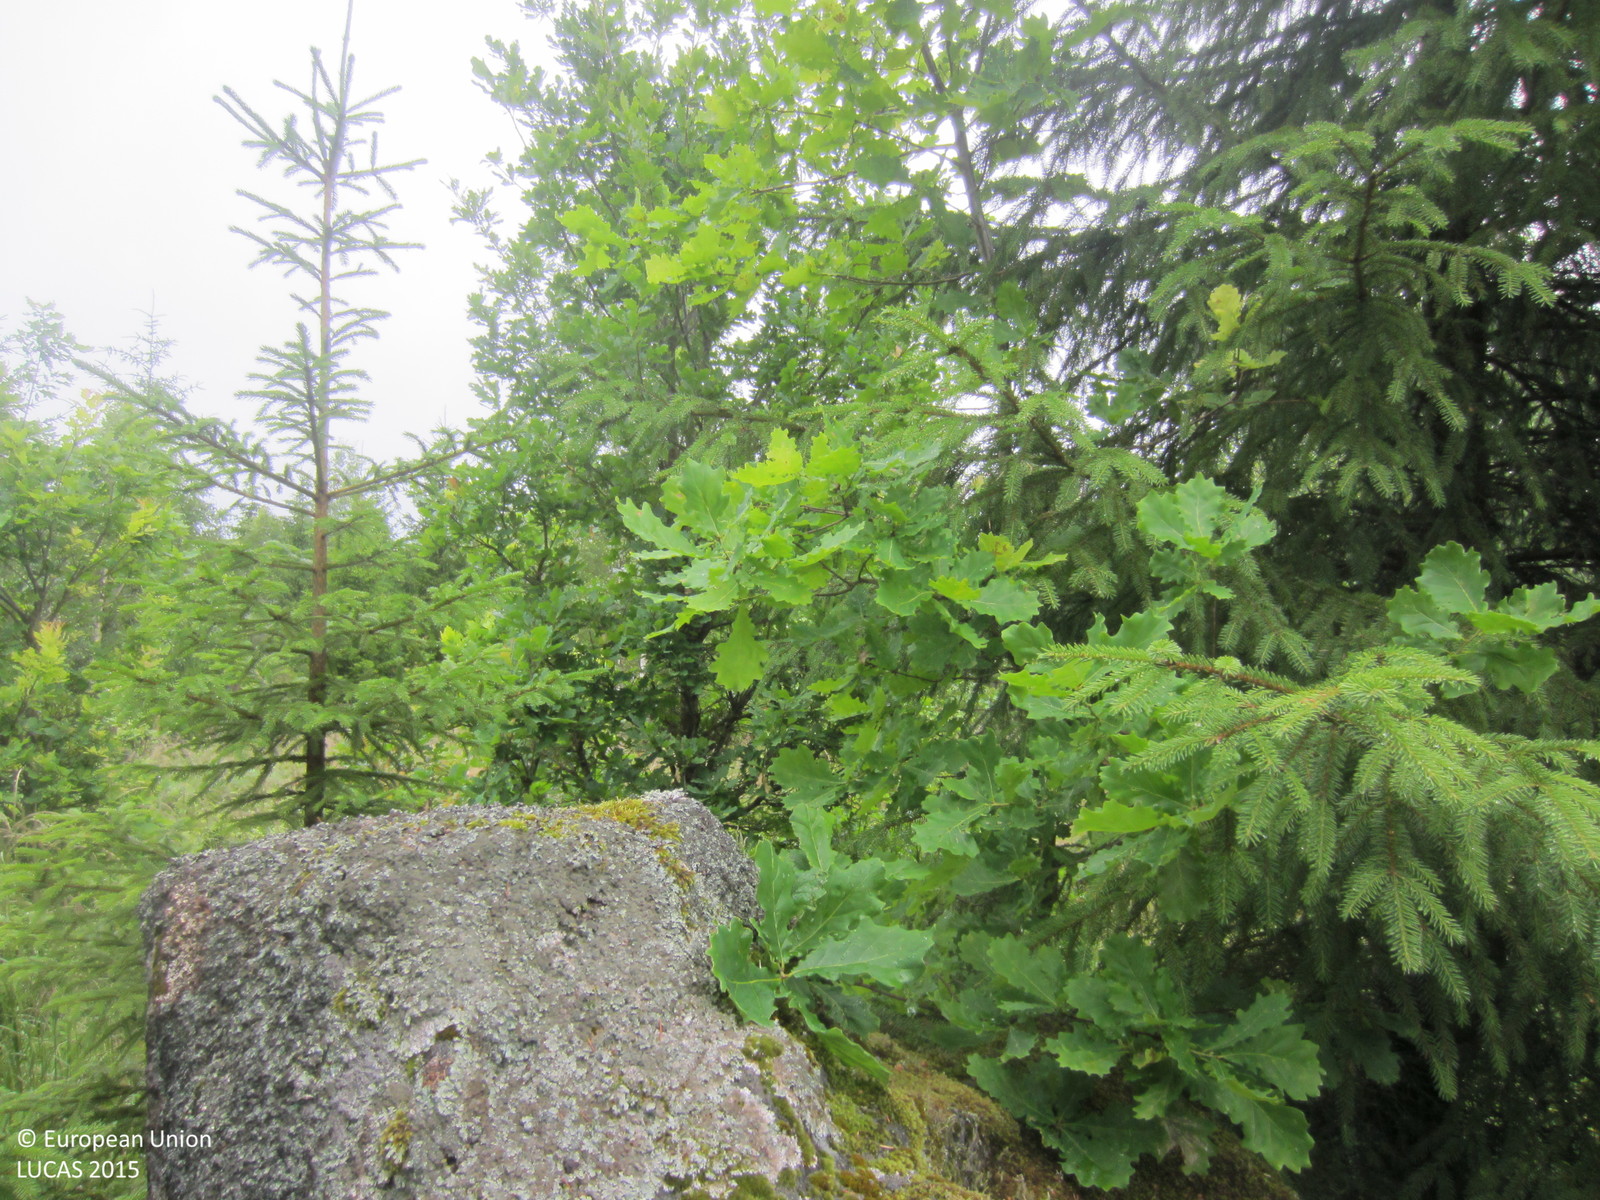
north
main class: Woodland
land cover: Spruce dominated coniferous woodland
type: boreal forest
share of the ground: 50 - 75 %
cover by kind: coniferous forest trees 55 %, herbaceous plants 20 %, lichens and mosses 20 %, broadleaved forest trees 5 %
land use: Forestry
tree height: > 5 m
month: July
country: SE
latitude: 59.8652
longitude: 16.9387
